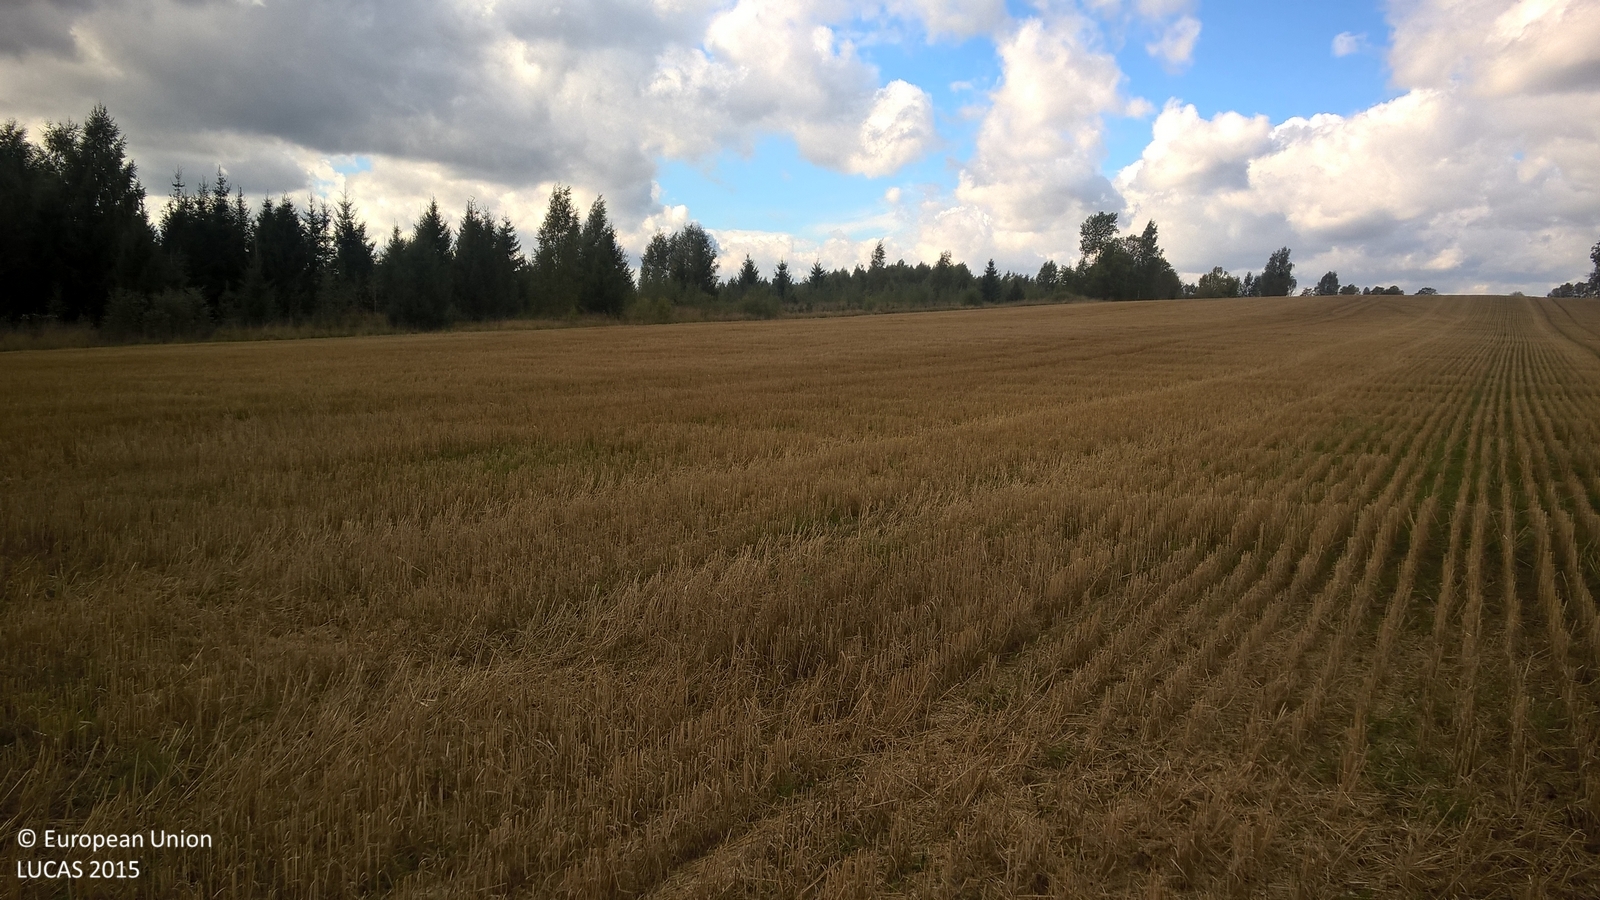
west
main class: Cropland
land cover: Common wheat
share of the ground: < 10 %
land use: Agriculture (excluding fallow land and kitchen gardens)
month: September
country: LV
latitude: 57.6765
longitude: 25.5247
